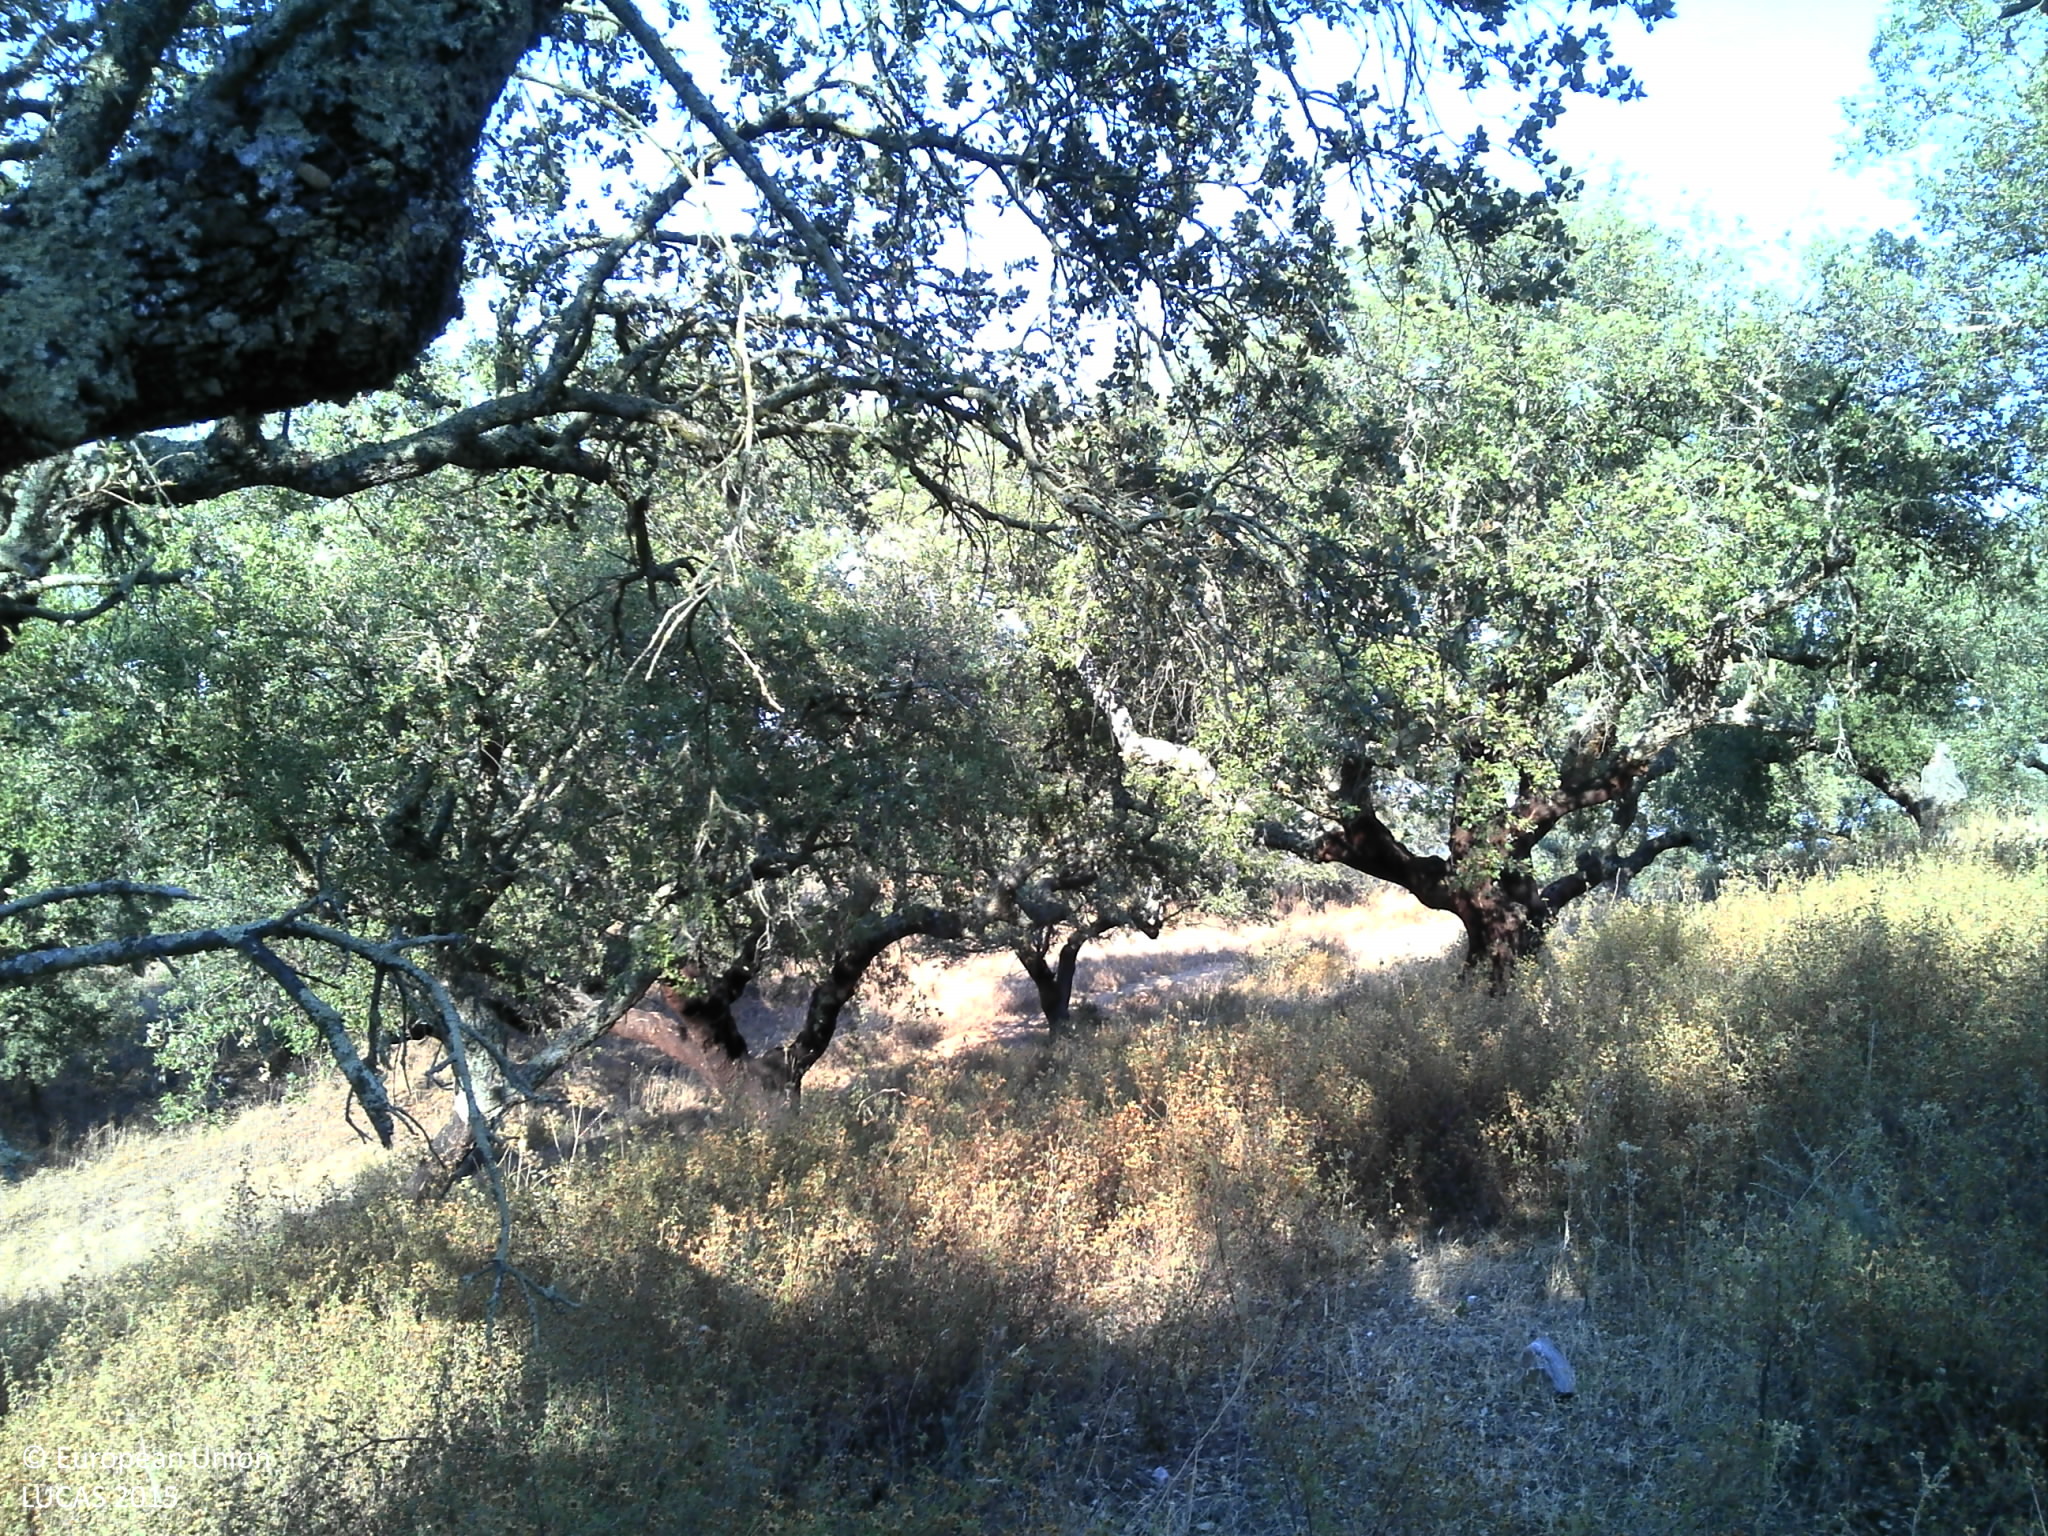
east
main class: Woodland
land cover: Broadleaved woodland
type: broadleaved evergreen forest
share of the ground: 50 - 75 %
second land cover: Grassland without tree/shrub cover
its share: 50 - 75 %
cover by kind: broadleaved forest trees 50 %, herbaceous plants 50 %
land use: Forestry
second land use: Agriculture (excluding fallow land and kitchen gardens)
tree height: > 5 m
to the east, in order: Broadleaved woodland; Grassland without tree/shrub cover; Broadleaved woodland; Tracks; Broadleaved woodland; Fences; Grassland without tree/shrub cover
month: June
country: PT
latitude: 38.3101
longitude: -7.6051
